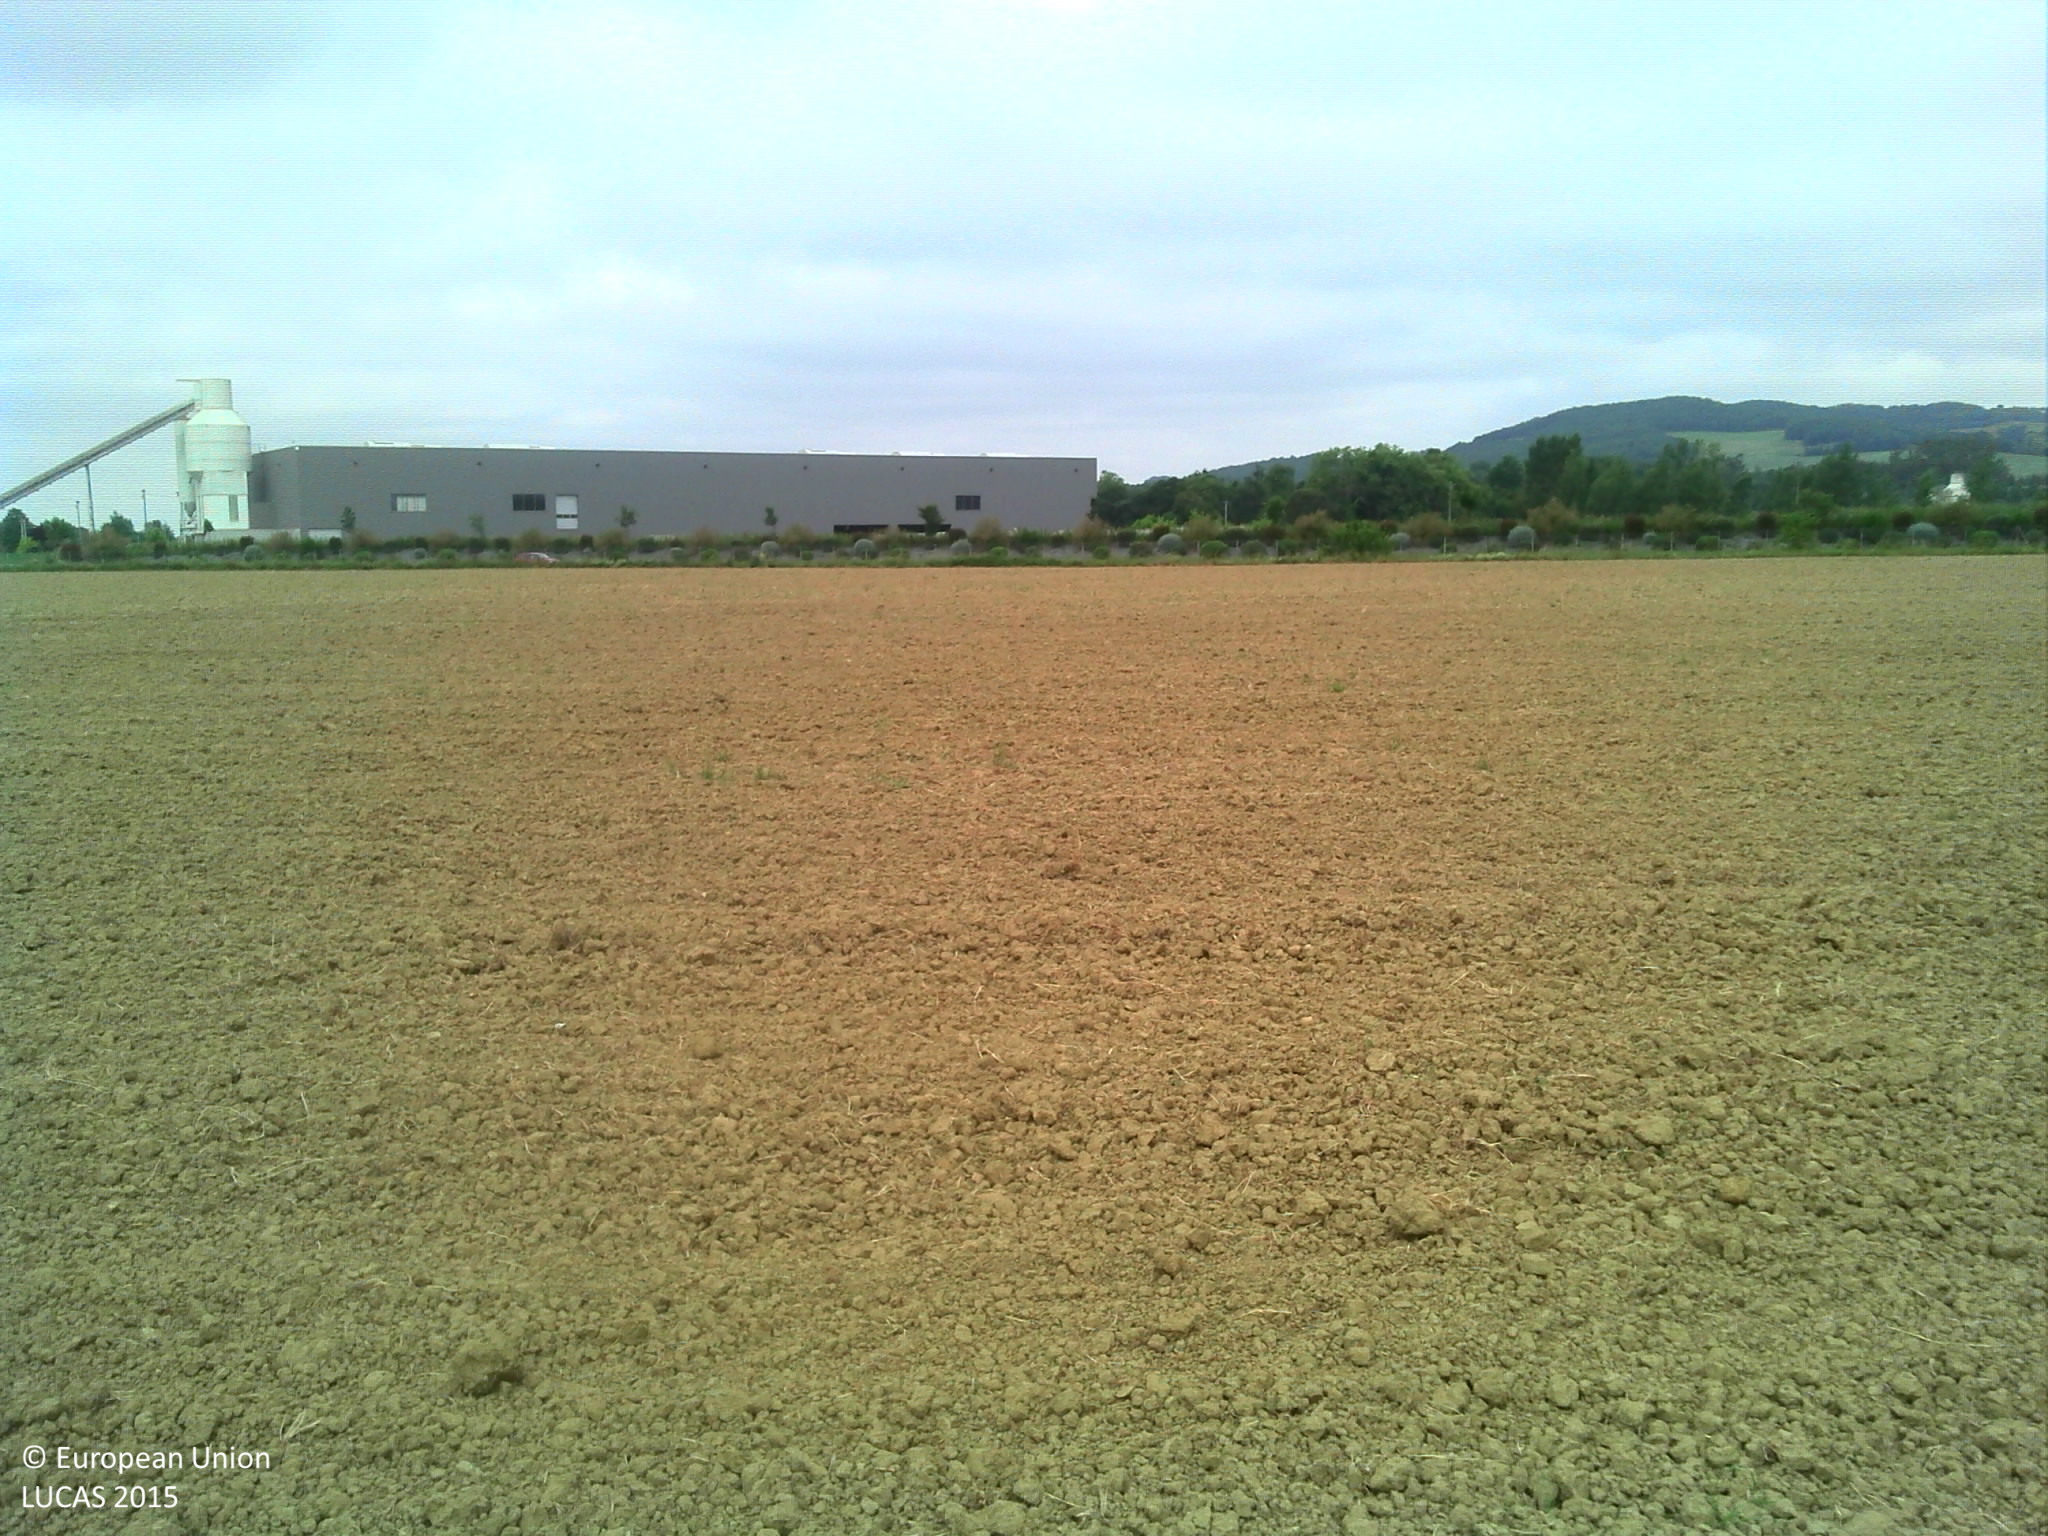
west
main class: Cropland
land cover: Common wheat
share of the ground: > 75 %
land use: Agriculture (excluding fallow land and kitchen gardens)
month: May
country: FR
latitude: 43.7670
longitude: 1.9667
